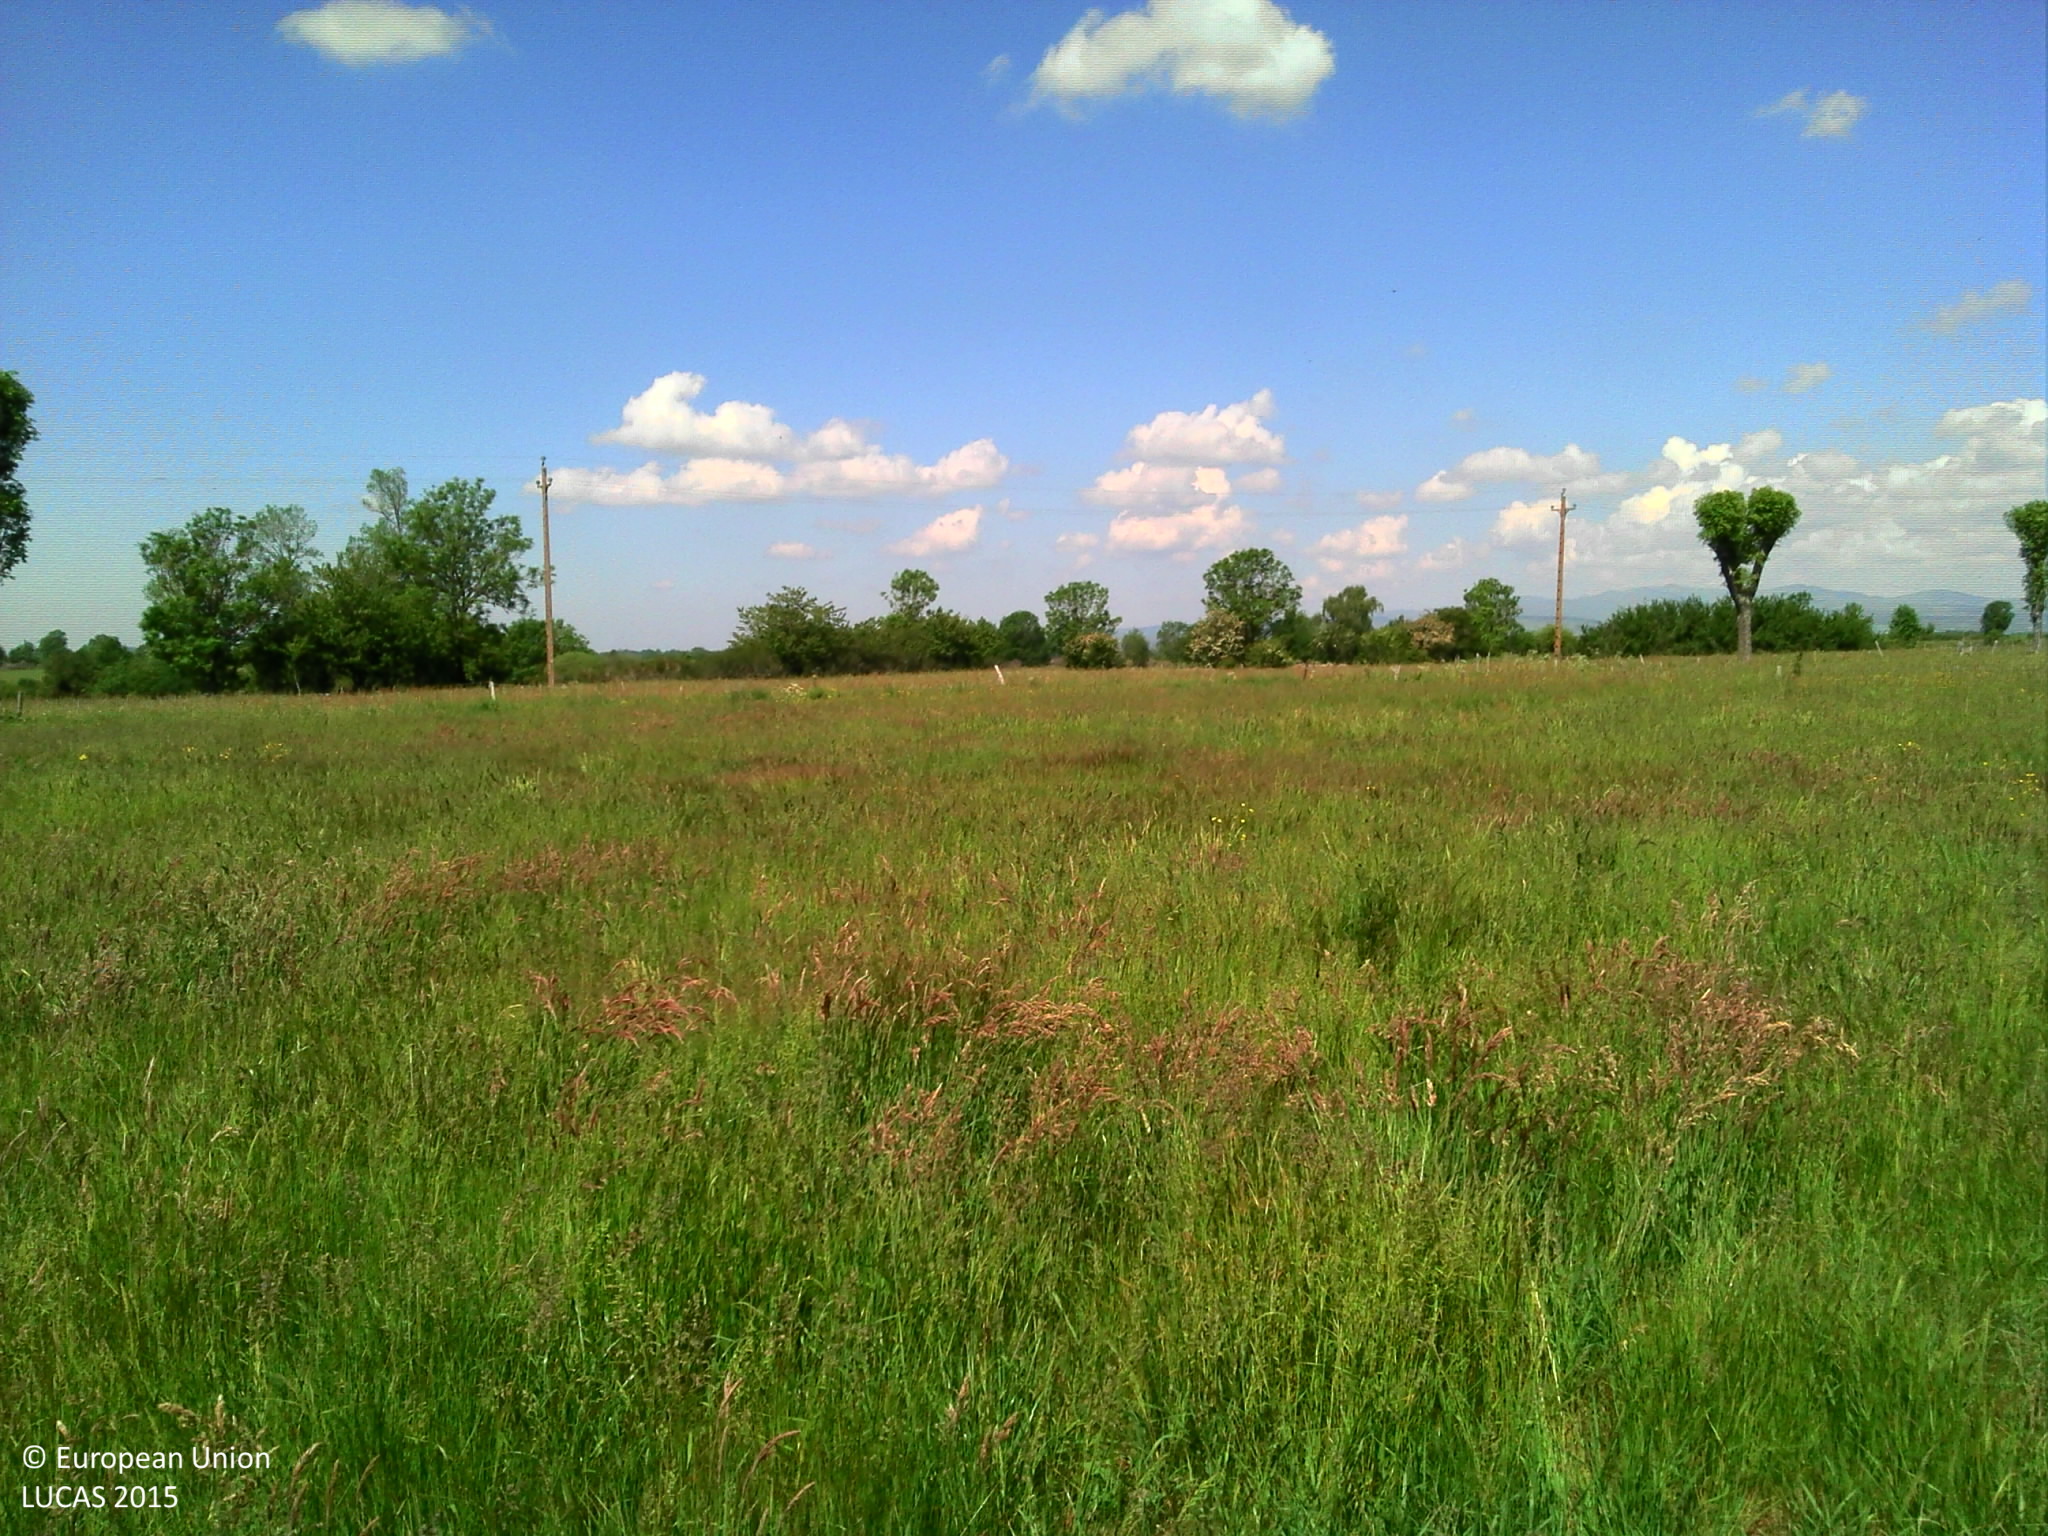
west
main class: Grassland
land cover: Grassland without tree/shrub cover
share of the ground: > 75 %
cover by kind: herbaceous plants 100 %
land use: Agriculture (excluding fallow land and kitchen gardens)
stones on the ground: < 10 %
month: June
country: FR
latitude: 44.9672
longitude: 3.0418
